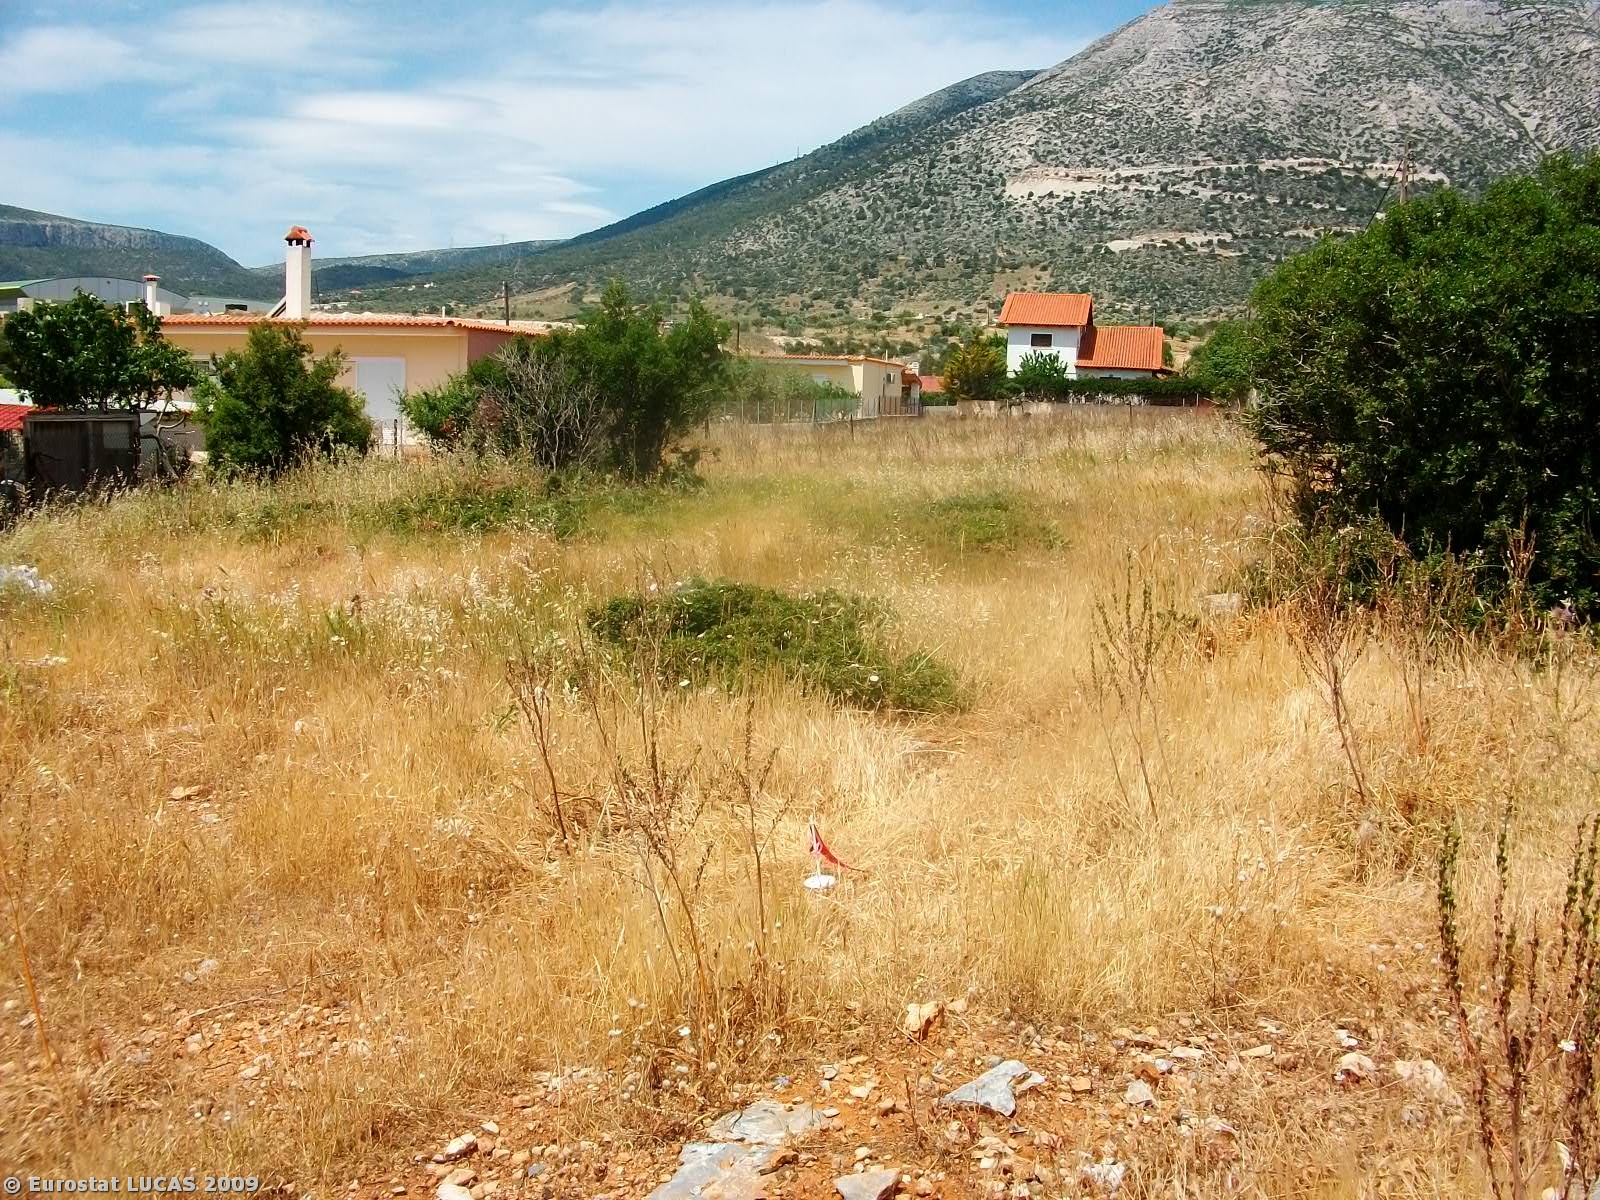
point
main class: Grassland
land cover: Spontaneously vegetated surfaces
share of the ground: > 75 %
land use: Unused
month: May
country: GR
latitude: 37.9405
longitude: 23.8519
